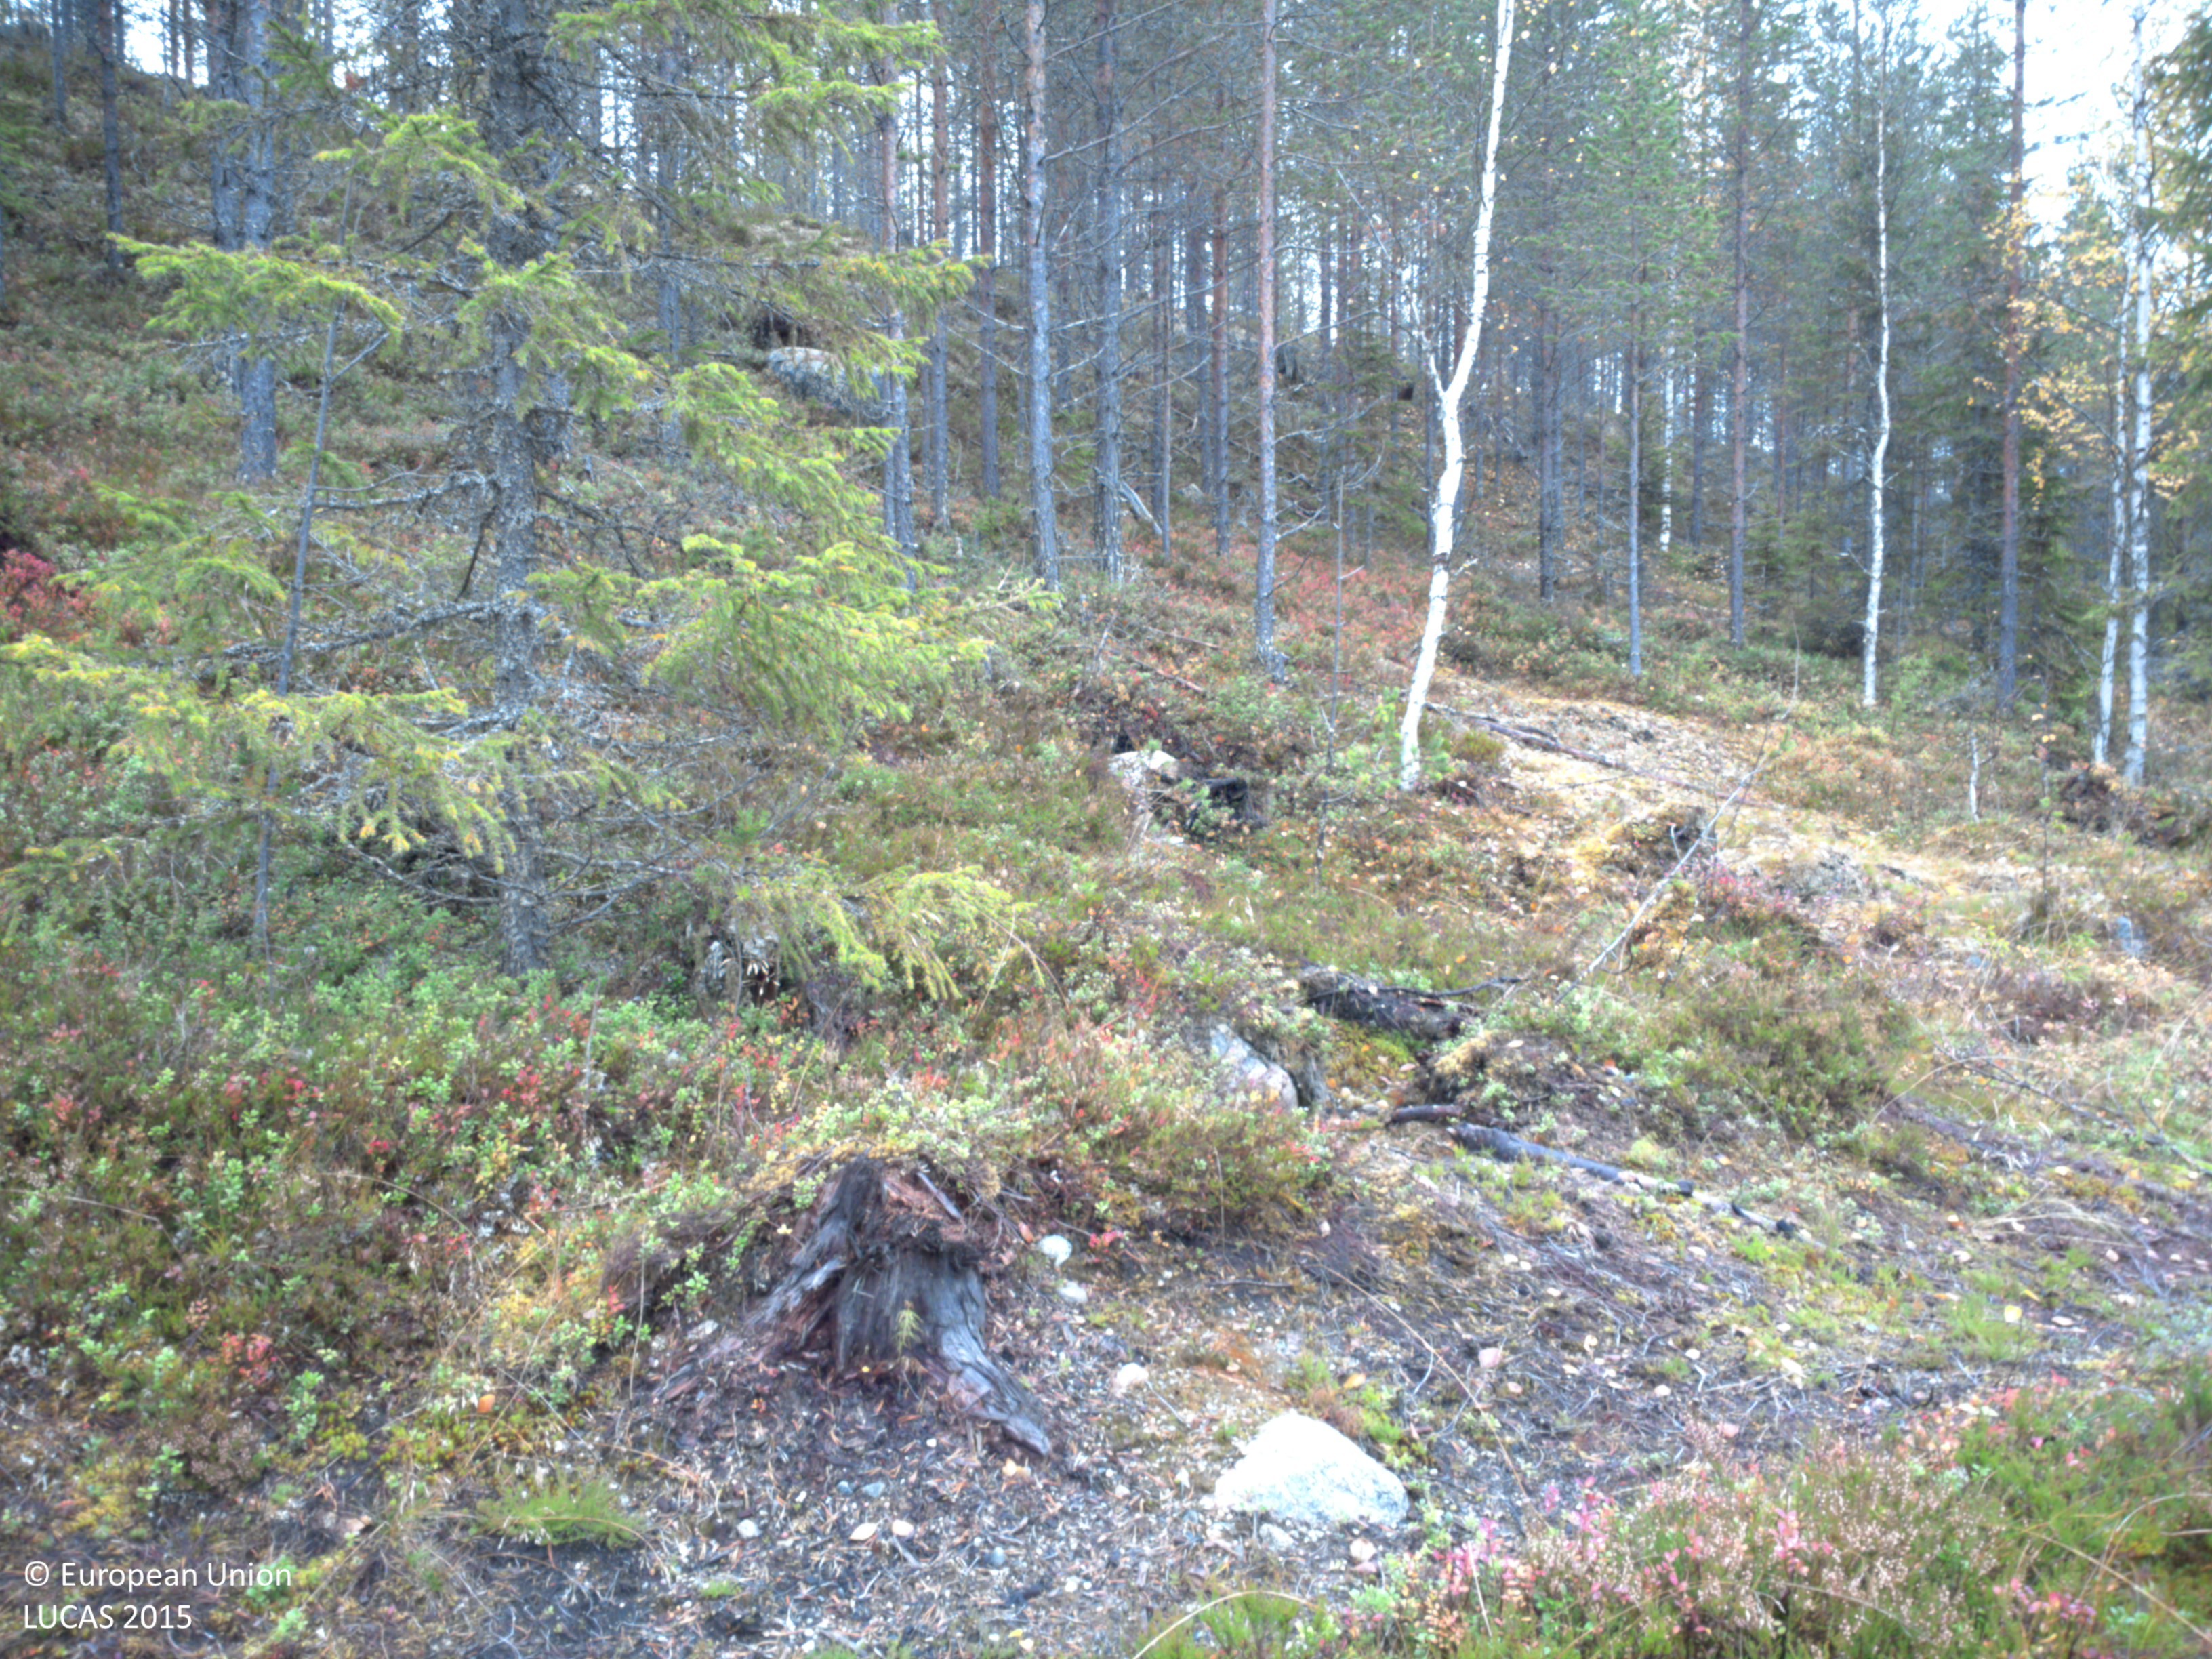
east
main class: Woodland
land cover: Spruce dominated mixed woodland
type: boreal forest
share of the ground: 25 - 50 %
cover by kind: coniferous forest trees 30 %, shrubs 30 %, broadleaved forest trees 20 %, herbaceous plants 10 %, lichens and mosses 10 %
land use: Forestry
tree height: < 5 m
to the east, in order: Spruce dominated mixed woodland; Pine dominated coniferous woodland; Other mixed woodland; Pine dominated coniferous woodland; Pine dominated mixed woodland; Other mixed woodland; Pine dominated coniferous woodland
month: September
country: SE
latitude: 64.8986
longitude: 18.8179
